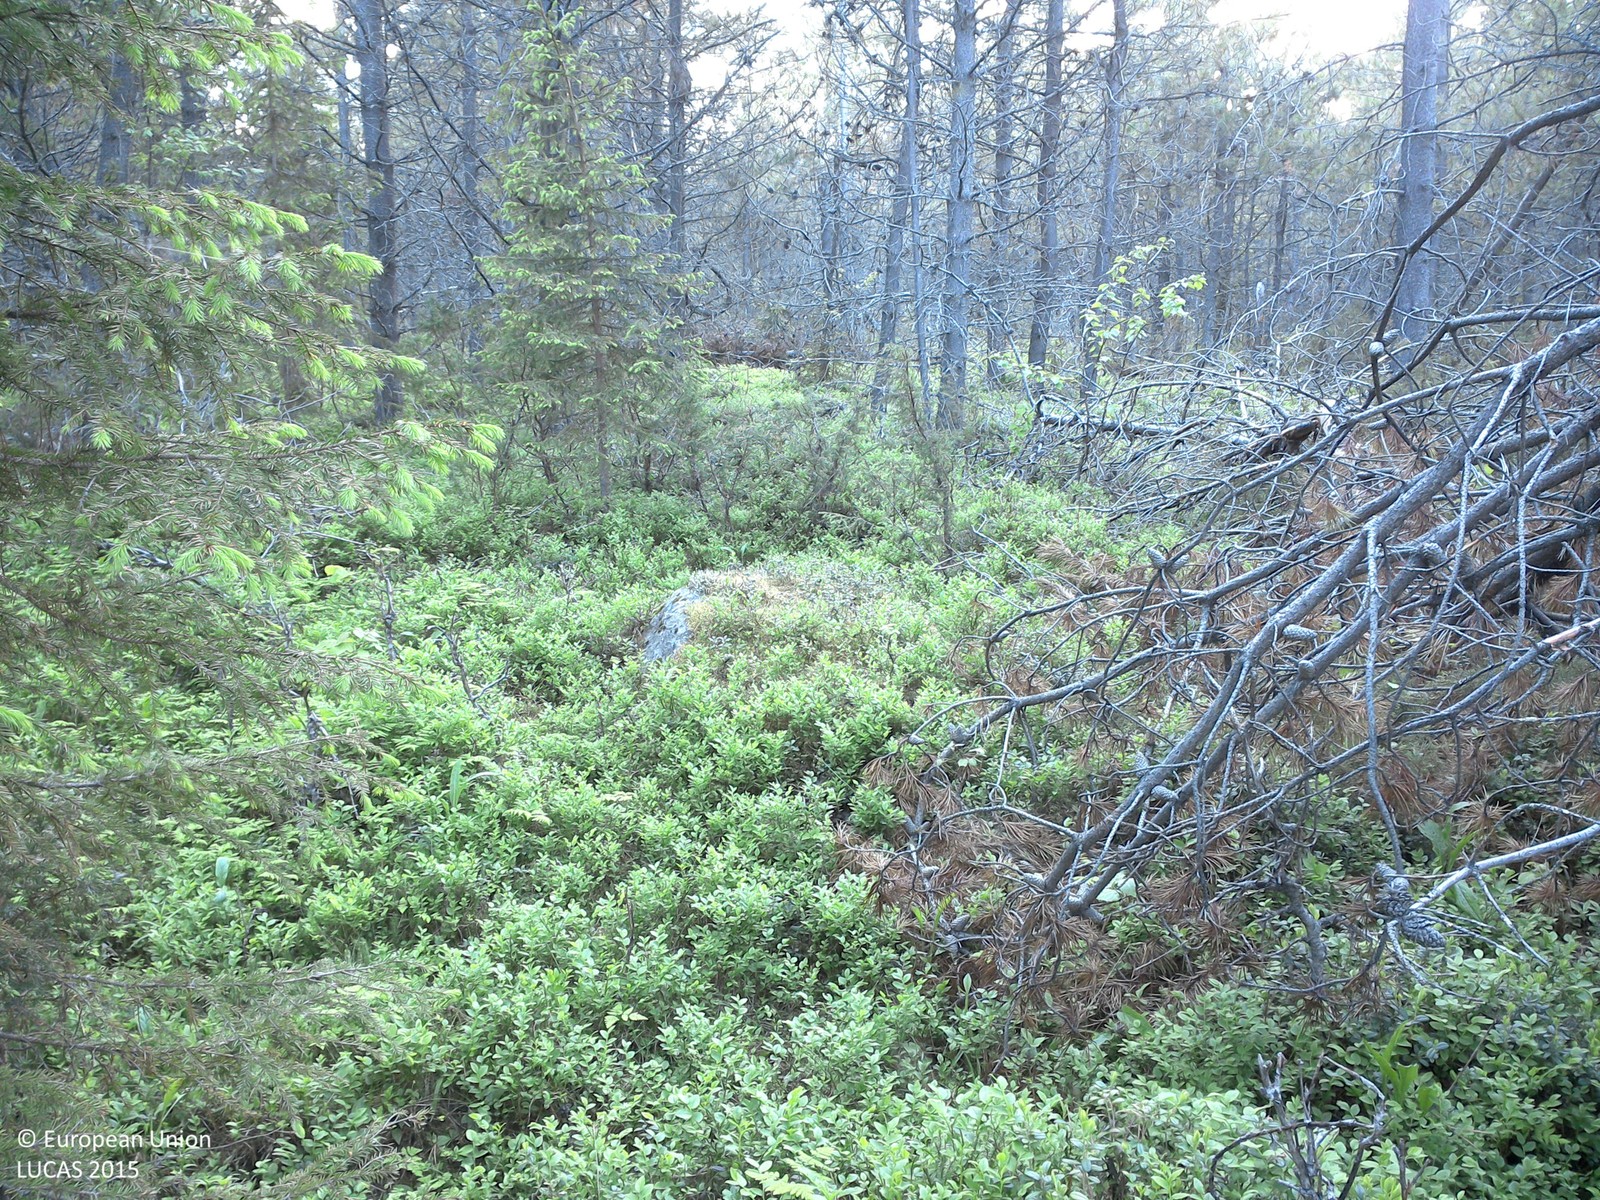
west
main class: Woodland
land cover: Pine dominated coniferous woodland
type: exotic forest
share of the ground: 25 - 50 %
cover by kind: shrubs 60 %, coniferous forest trees 40 %
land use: Forestry
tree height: > 5 m
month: June
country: SE
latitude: 66.5997
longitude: 22.9956
